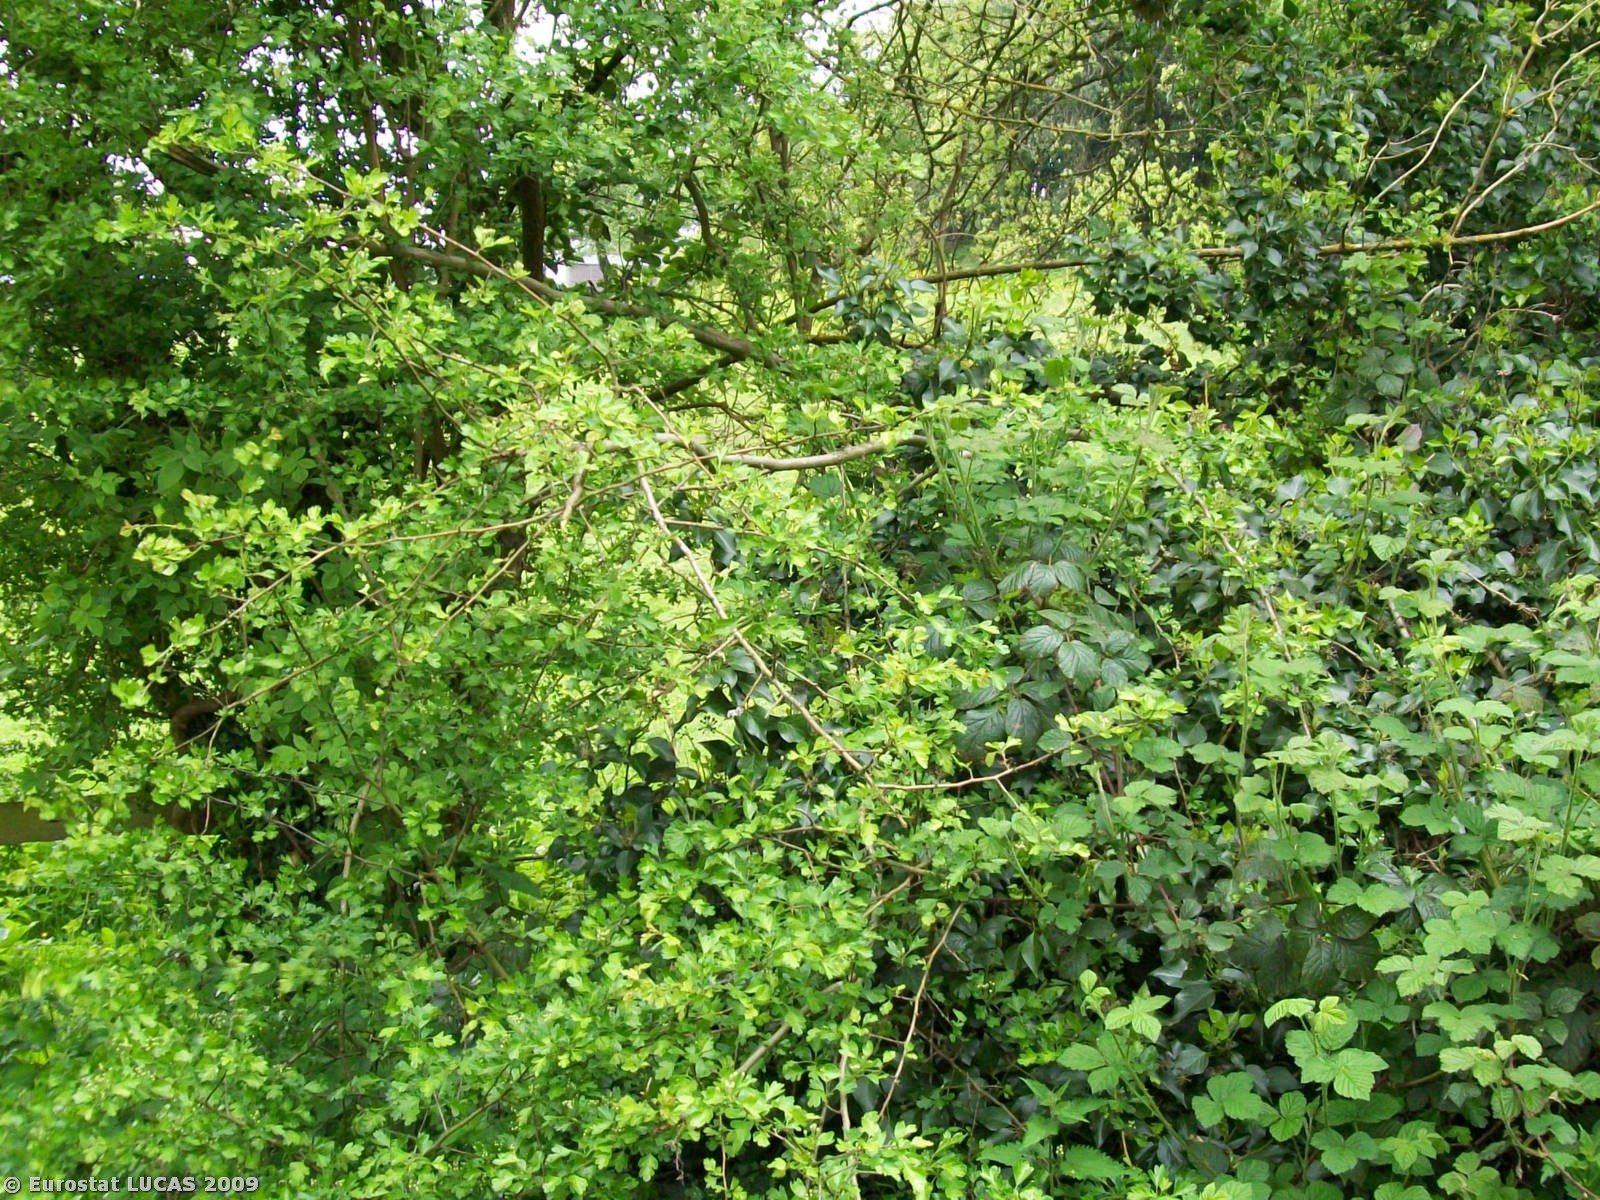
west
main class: Woodland
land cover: Broadleaved woodland
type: mesophytic deciduous forest
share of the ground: 25 - 50 %
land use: Unused
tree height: > 5 m
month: May
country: GB
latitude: 52.3359
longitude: -2.4671
